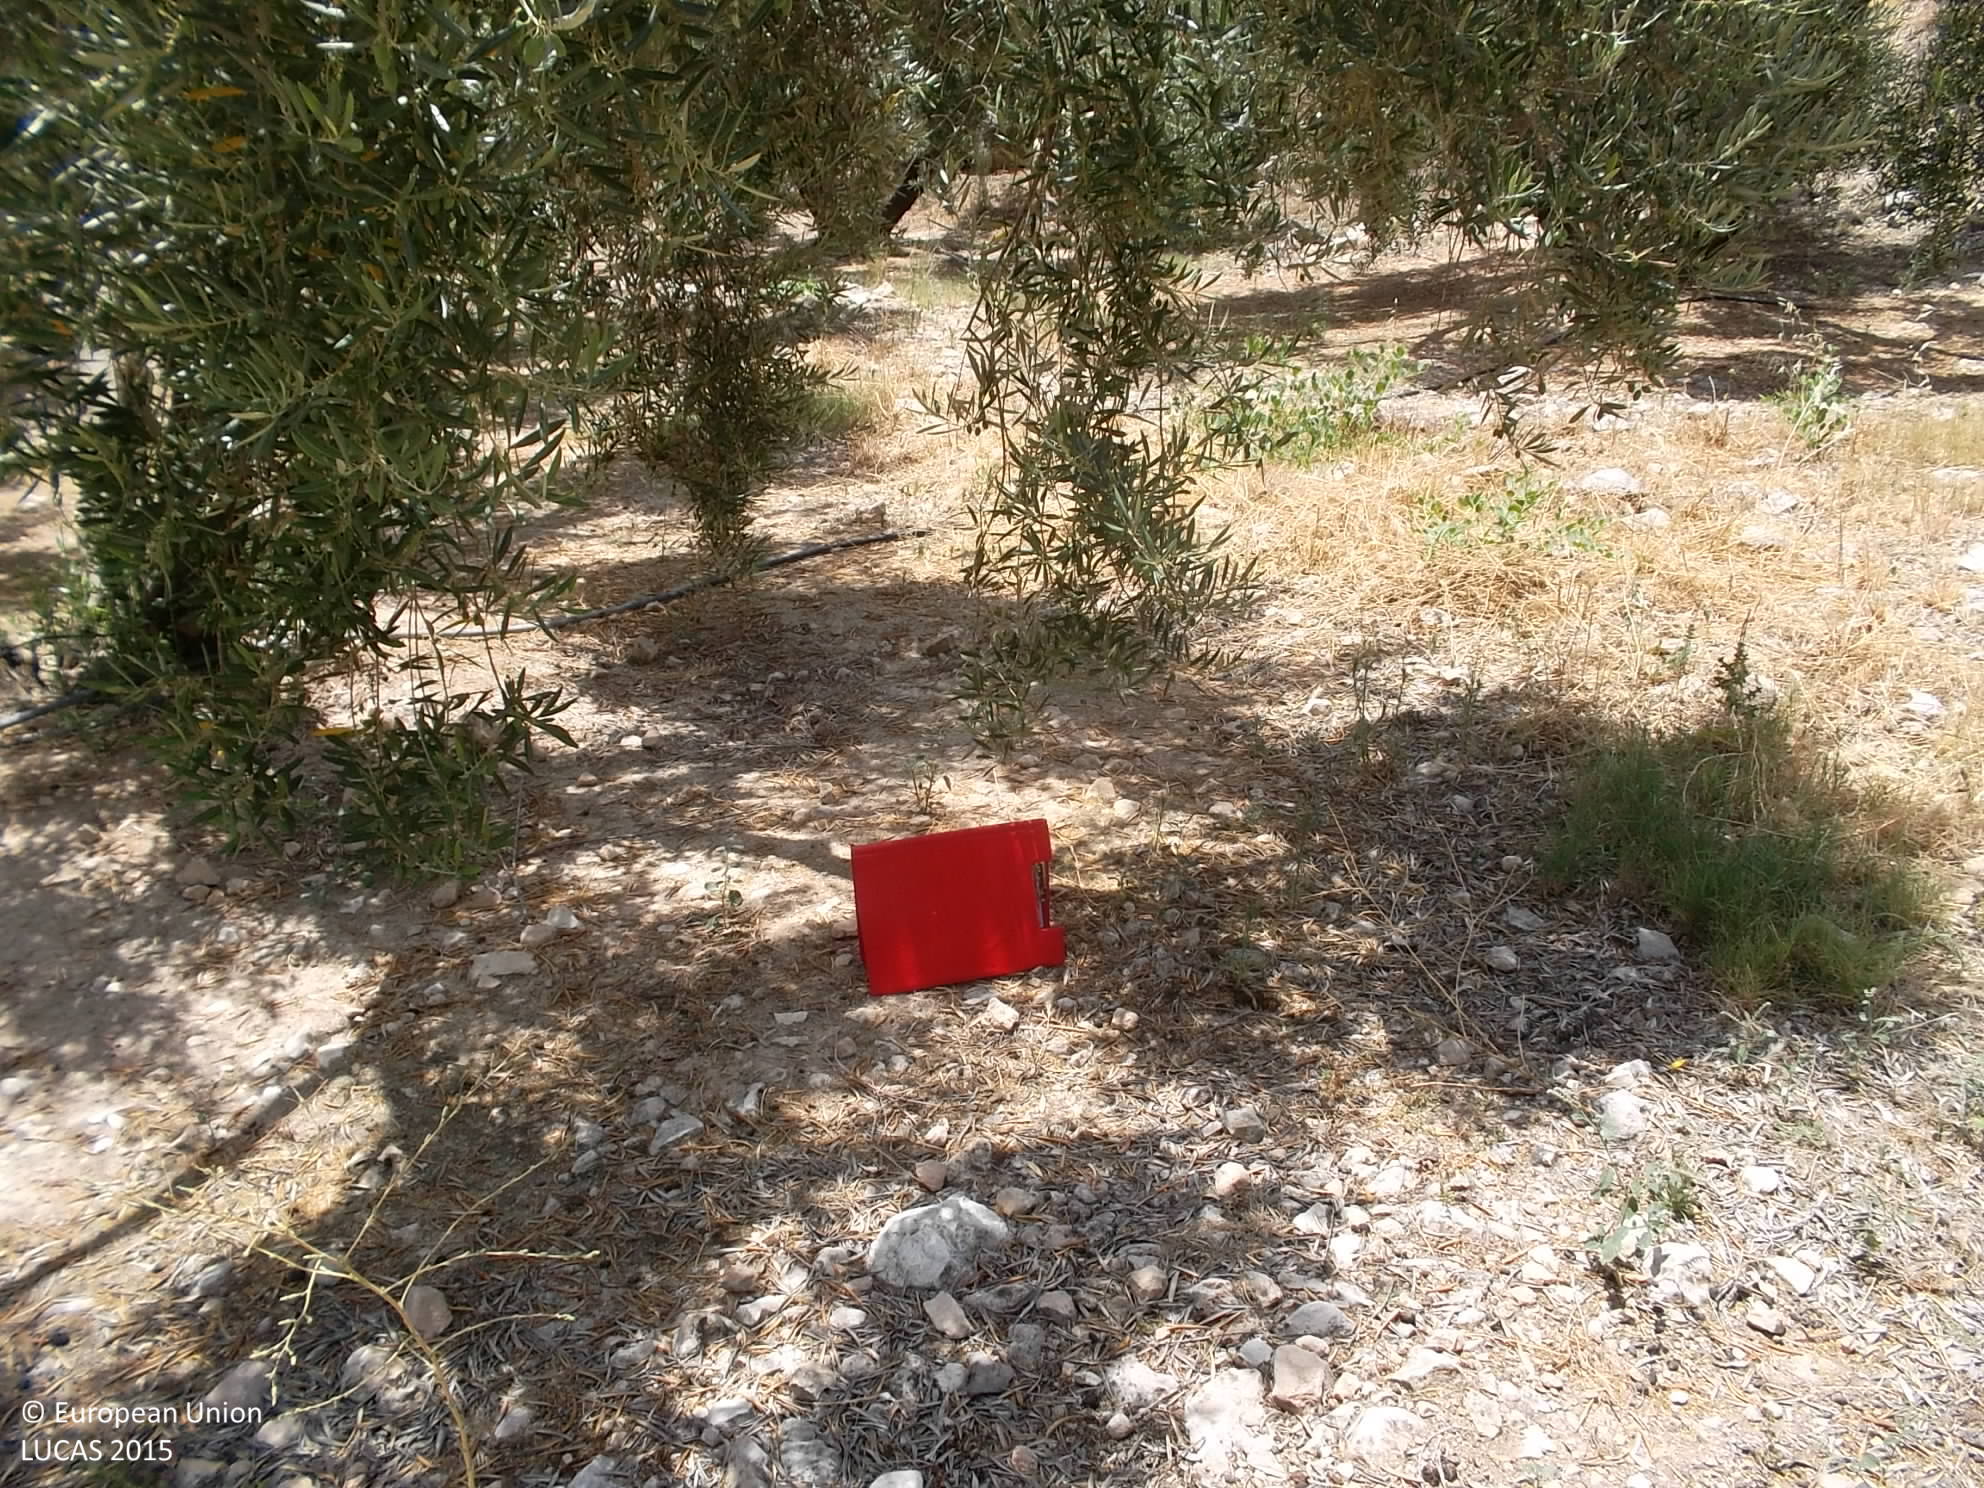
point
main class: Cropland
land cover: Olive groves
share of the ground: 25 - 50 %
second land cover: Spontaneously vegetated surfaces
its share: > 75 %
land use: Agriculture (excluding fallow land and kitchen gardens)
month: June
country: ES
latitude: 37.7452
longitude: -3.0327
